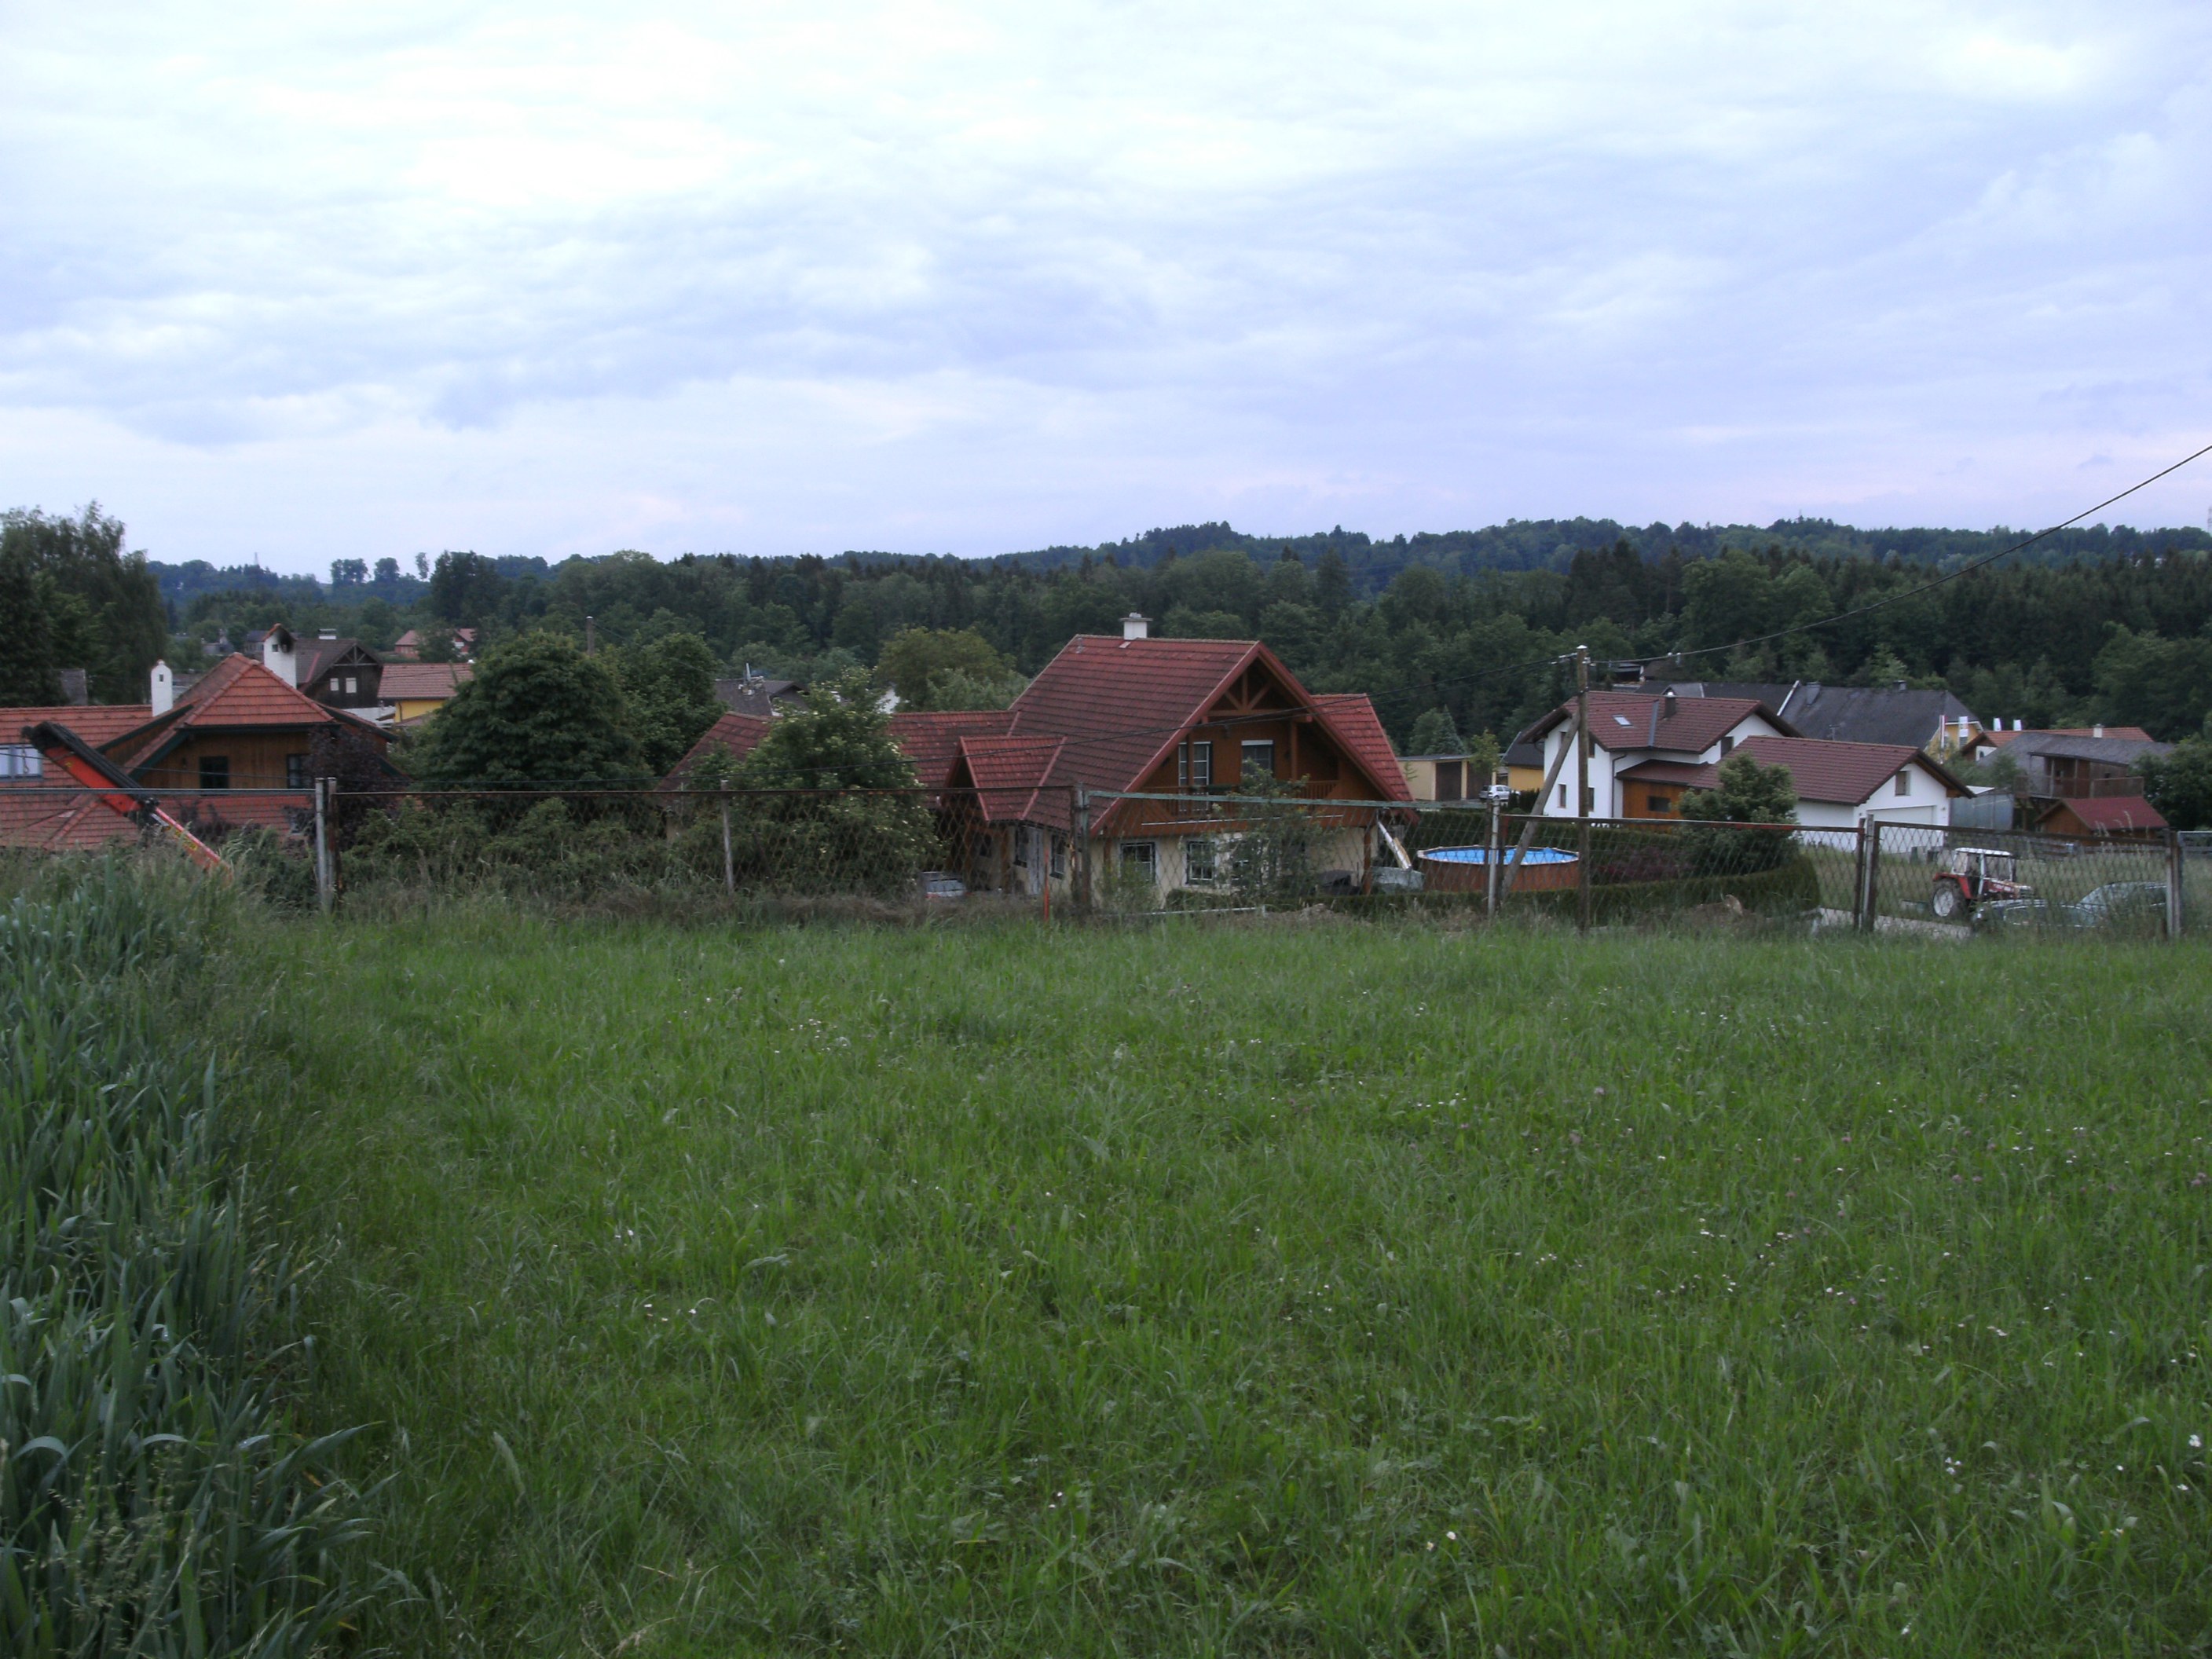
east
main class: Cropland
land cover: Common wheat
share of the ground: > 75 %
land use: Agriculture (excluding fallow land and kitchen gardens)
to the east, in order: Common wheat; Grassland without tree/shrub cover; Fences; Other bare soil; Fences; Paved roads, cycling and walking lanes; Other bare soil; Artificial constructions in urban areas; Grassland without tree/shrub cover; Fences; Grassland without tree/shrub cover; Artificial constructions in urban areas
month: May
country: AT
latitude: 48.0142
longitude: 13.7932
